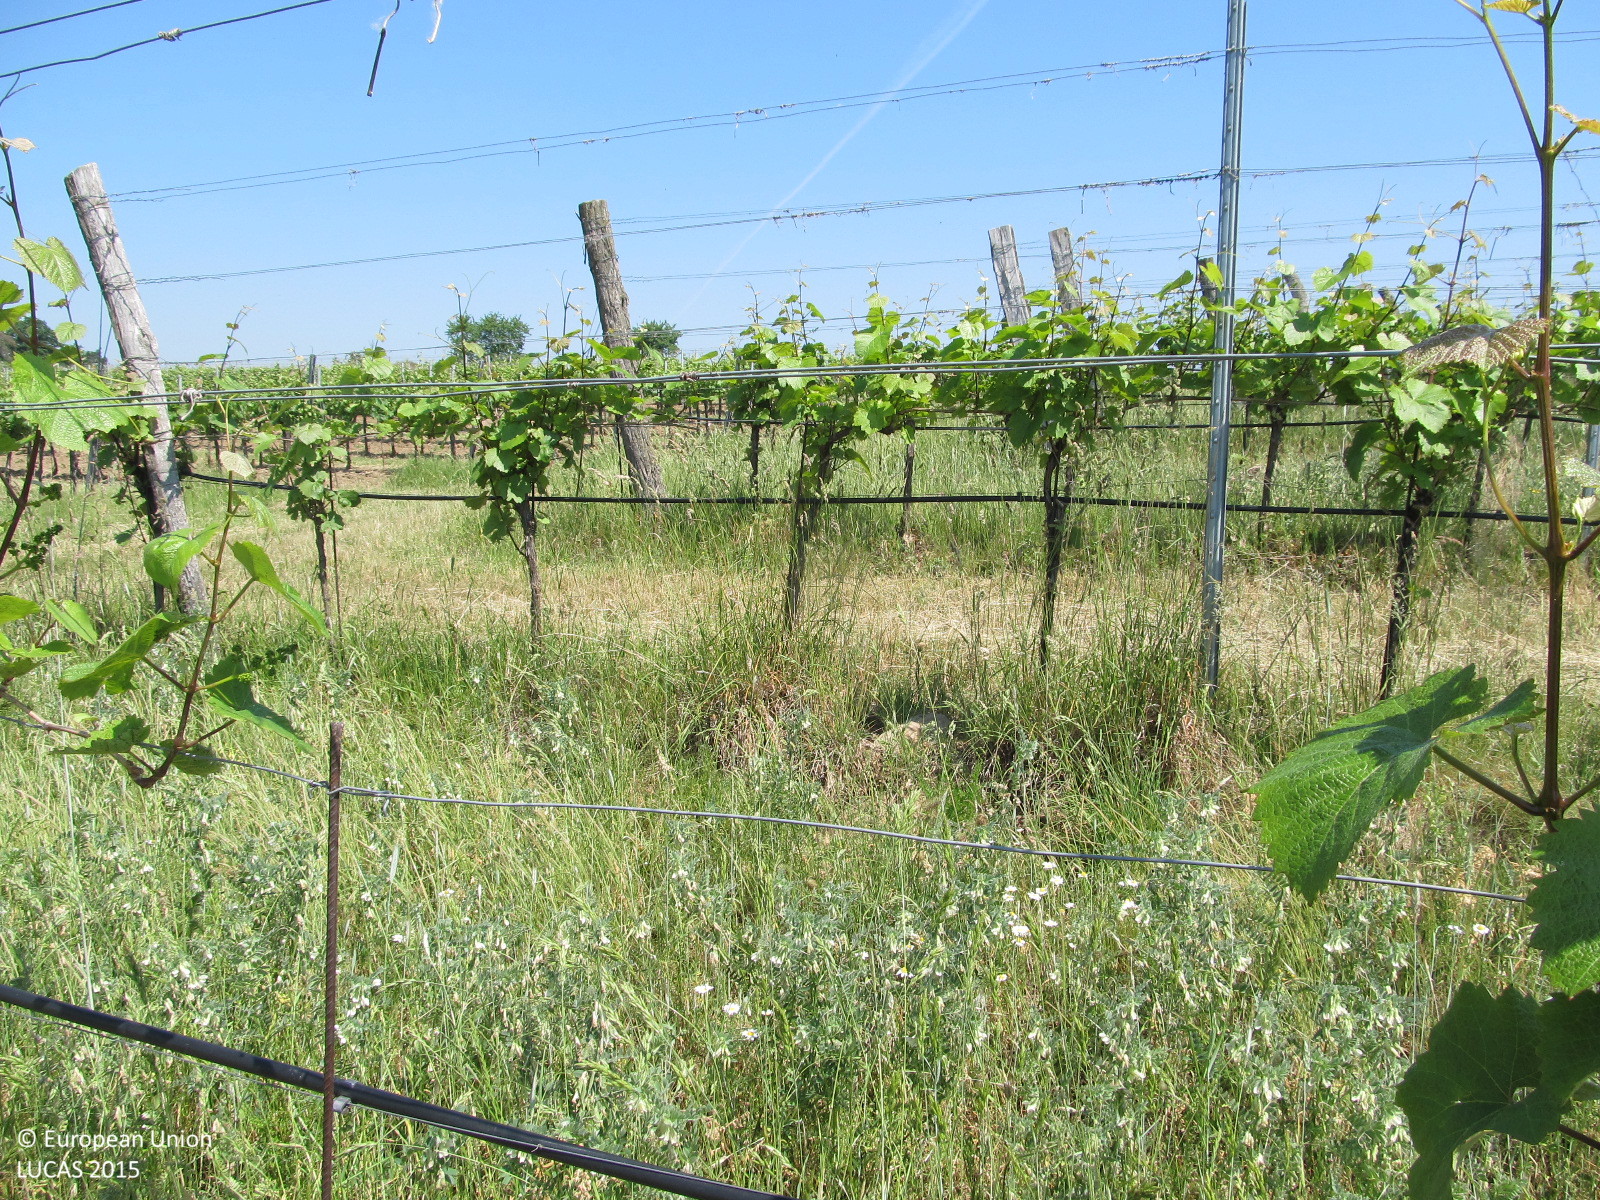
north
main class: Cropland
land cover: Vineyards
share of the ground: 10 - 25 %
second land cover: Grassland without tree/shrub cover
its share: > 75 %
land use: Agriculture (excluding fallow land and kitchen gardens)
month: May
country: AT
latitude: 48.4937
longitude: 15.6460
